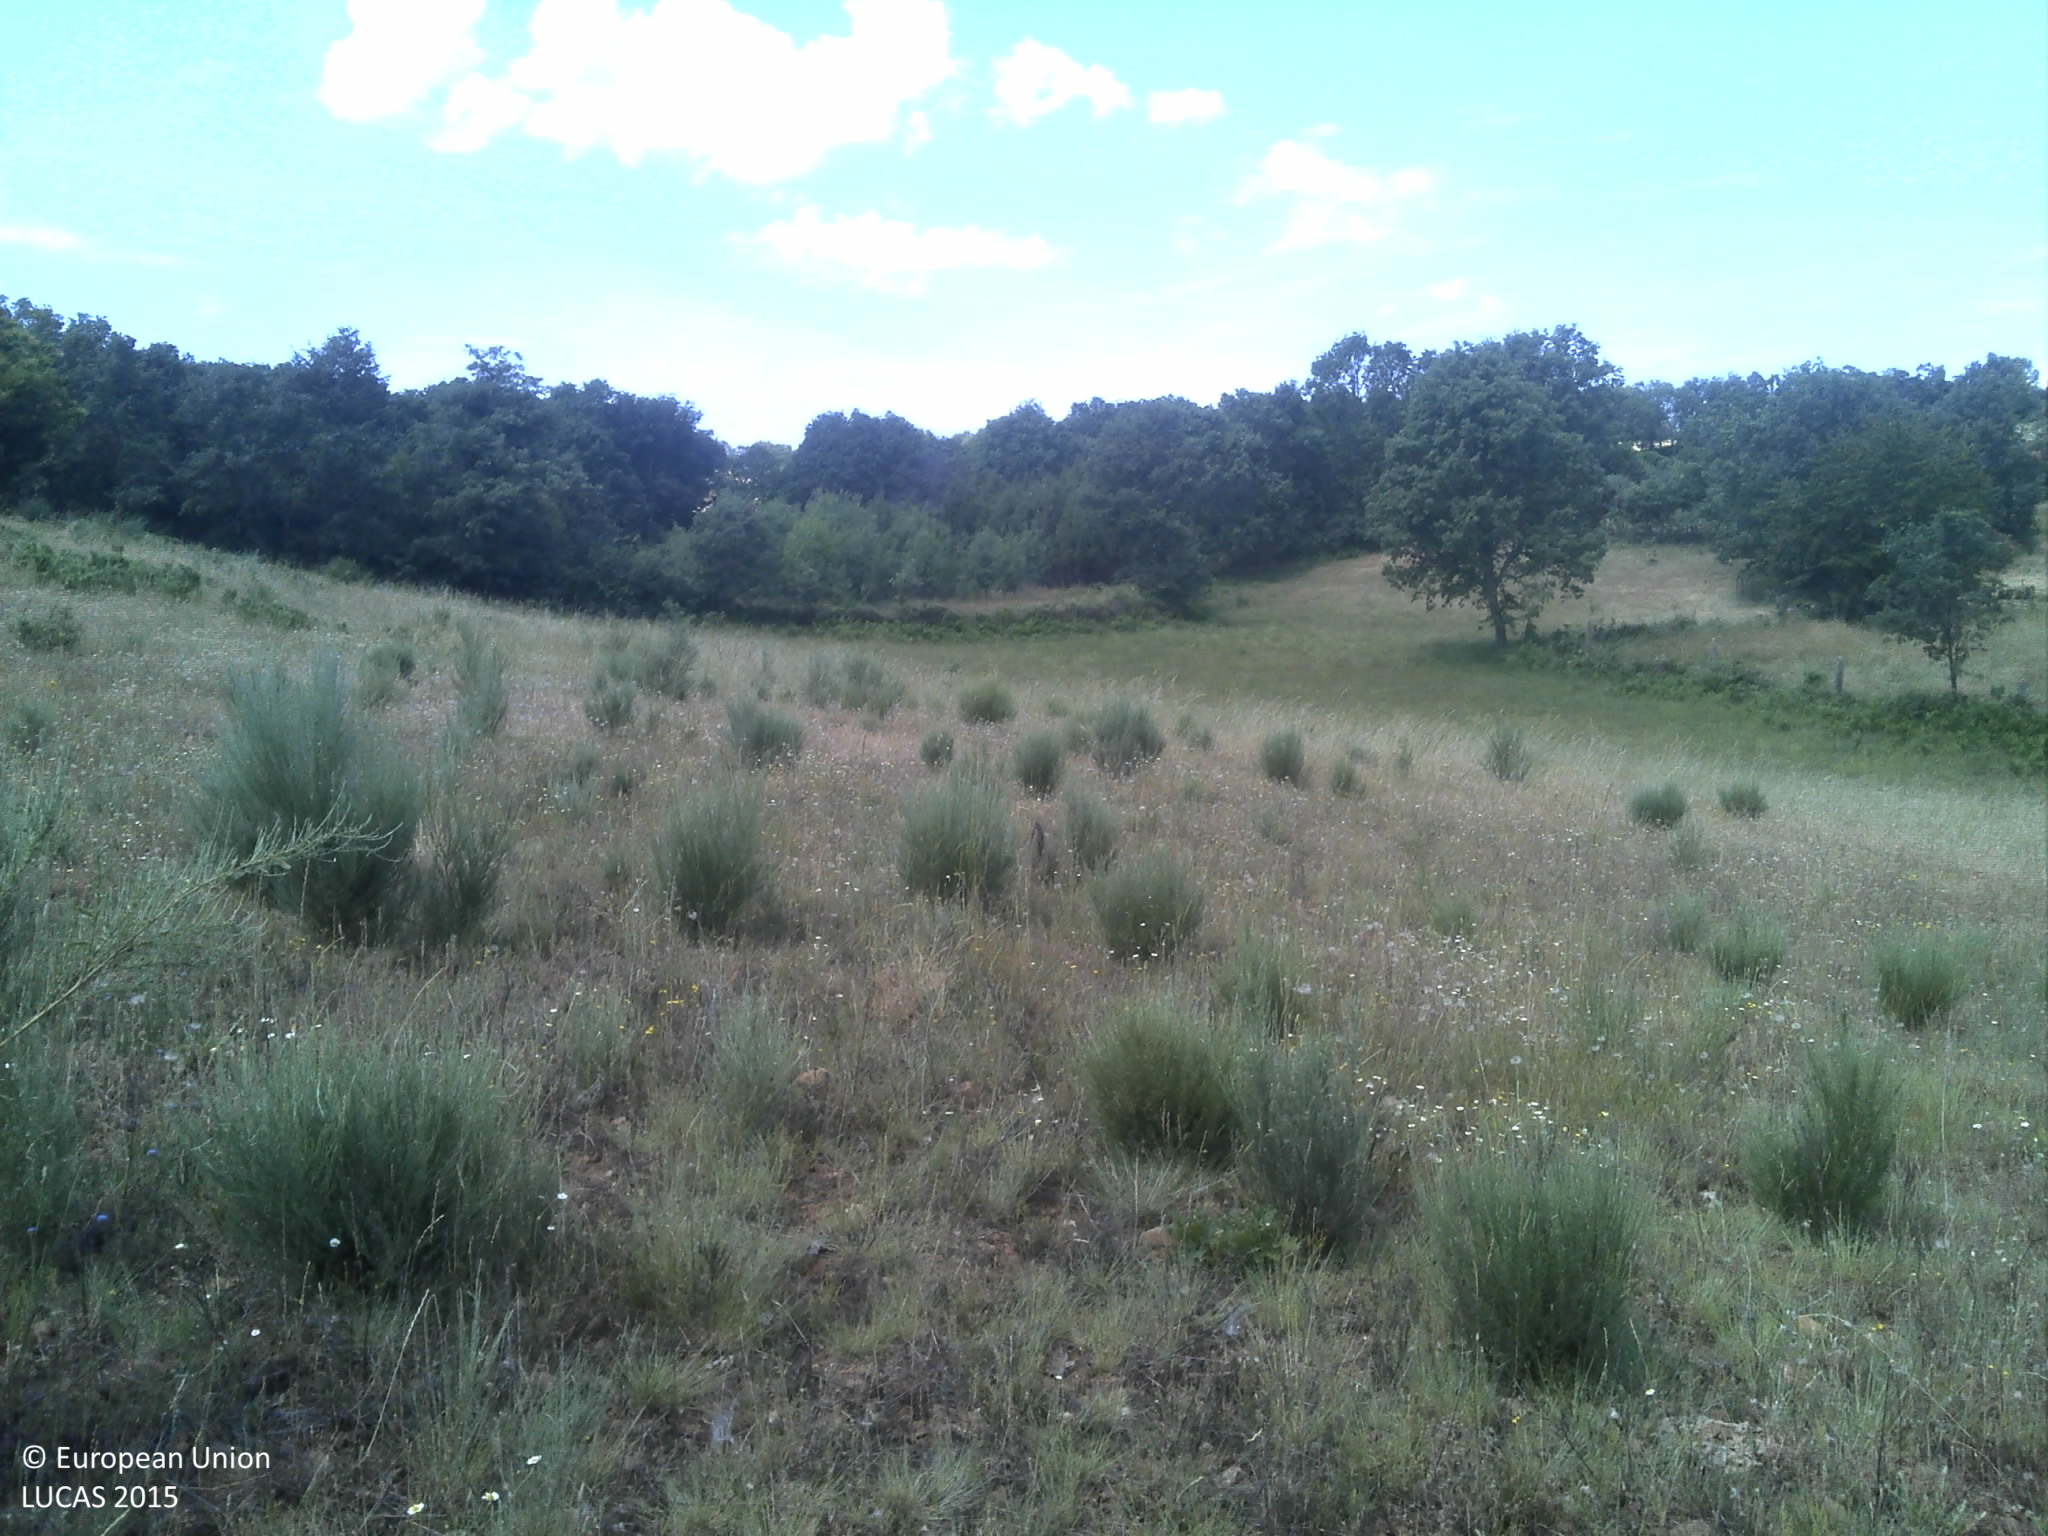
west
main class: Grassland
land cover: Grassland without tree/shrub cover
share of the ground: 25 - 50 %
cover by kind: herbaceous plants 50 %, unconsolidated bare surface 40 %, shrubs 5 %
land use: Agriculture (excluding fallow land and kitchen gardens)
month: June
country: PT
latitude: 40.3446
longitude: -6.9657
